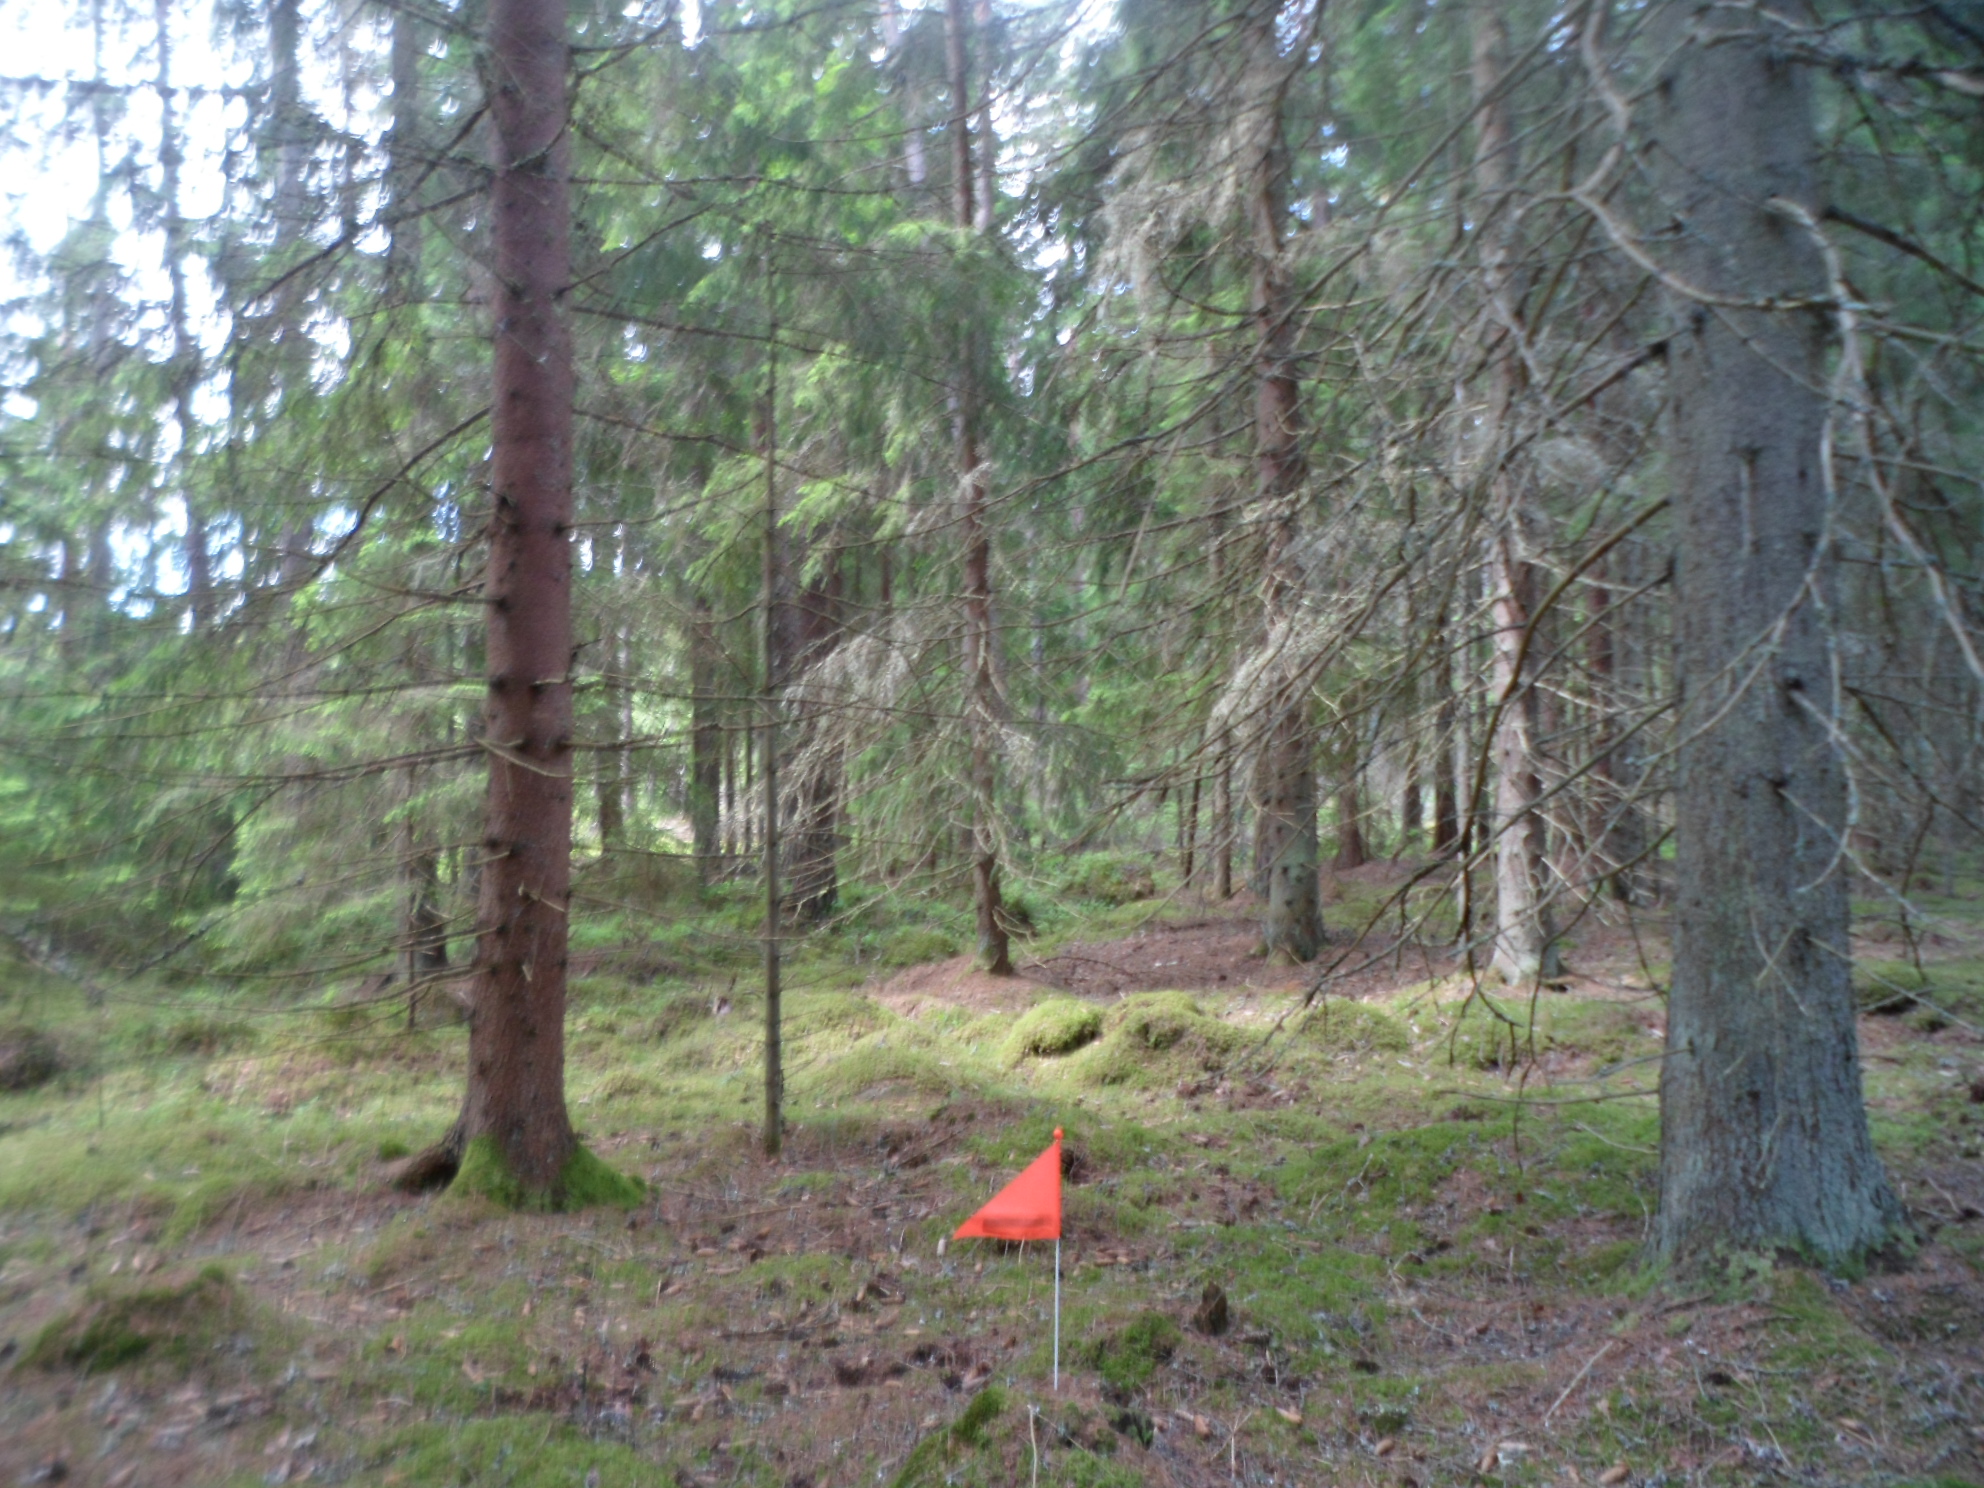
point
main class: Woodland
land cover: Spruce dominated coniferous woodland
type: boreal forest
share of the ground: > 75 %
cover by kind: coniferous forest trees 75 %, lichens and mosses 20 %, shrubs 5 %
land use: Forestry
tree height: > 5 m
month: June
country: SE
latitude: 57.1773
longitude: 14.8432
